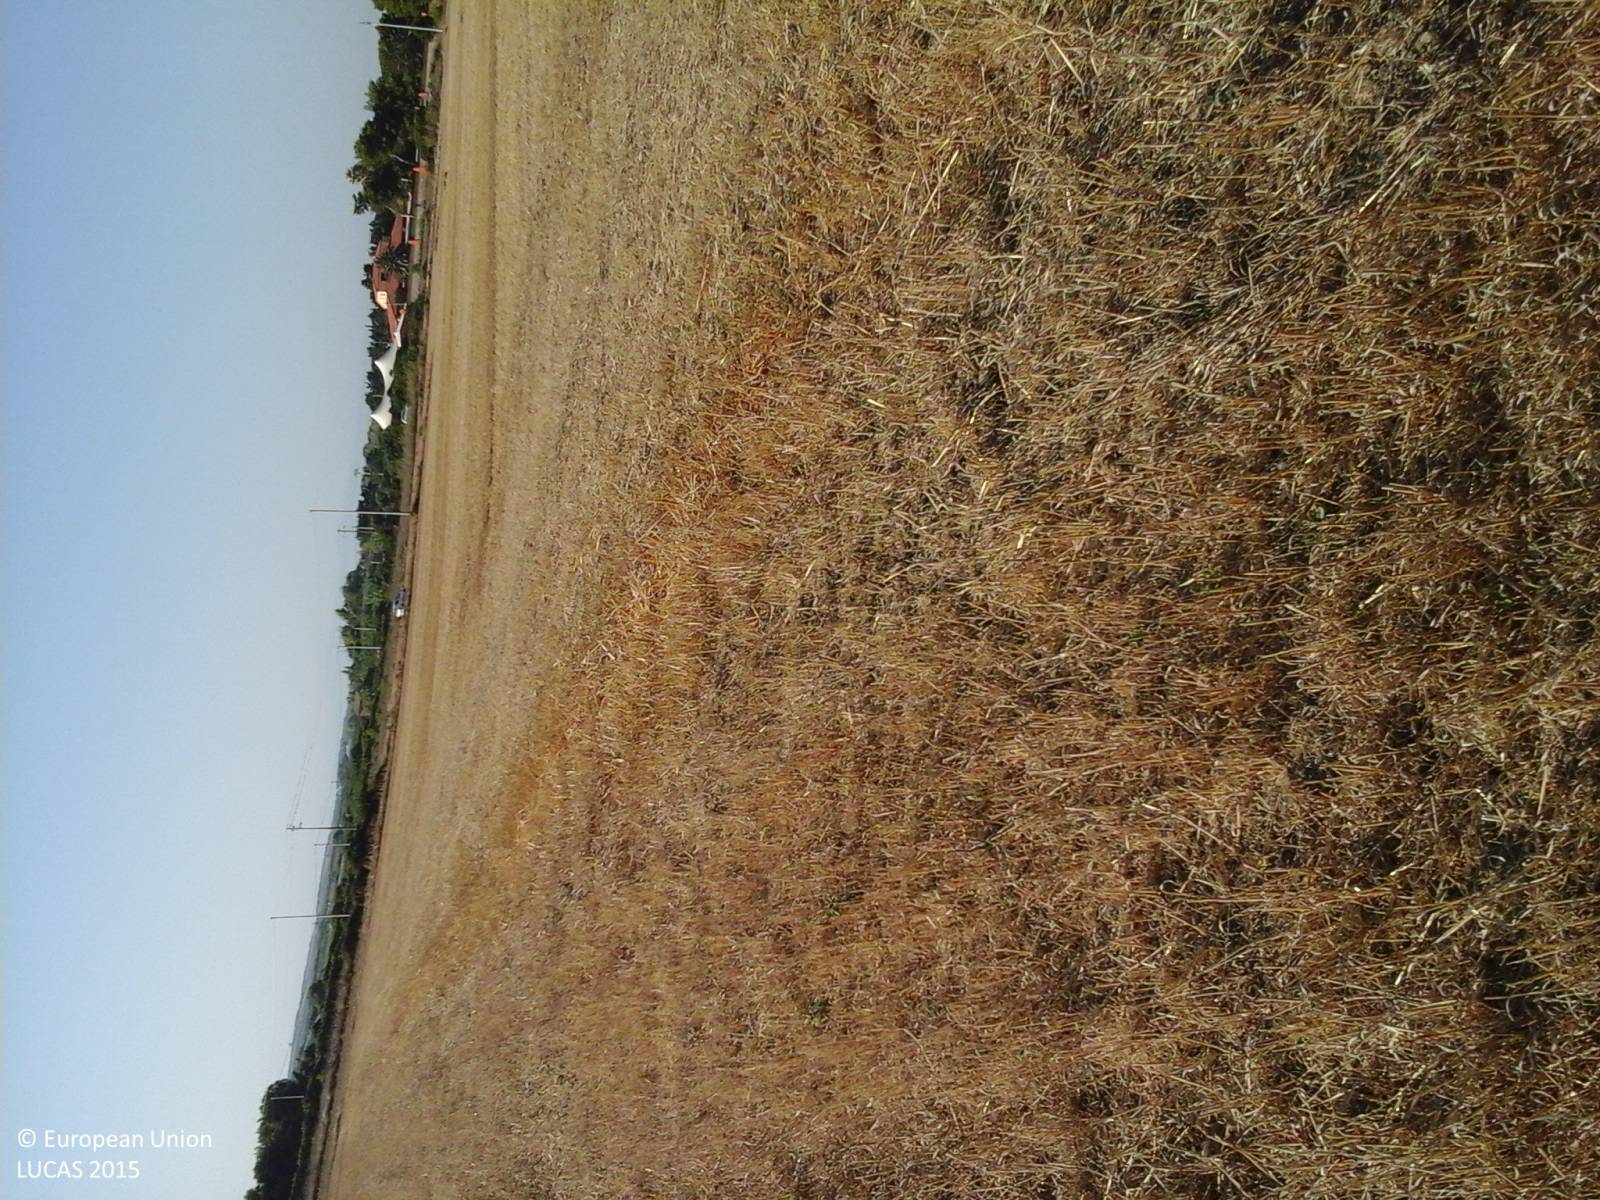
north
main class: Cropland
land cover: Barley
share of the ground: < 10 %
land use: Agriculture (excluding fallow land and kitchen gardens)
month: August
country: IT
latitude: 40.0197
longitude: 8.4501
